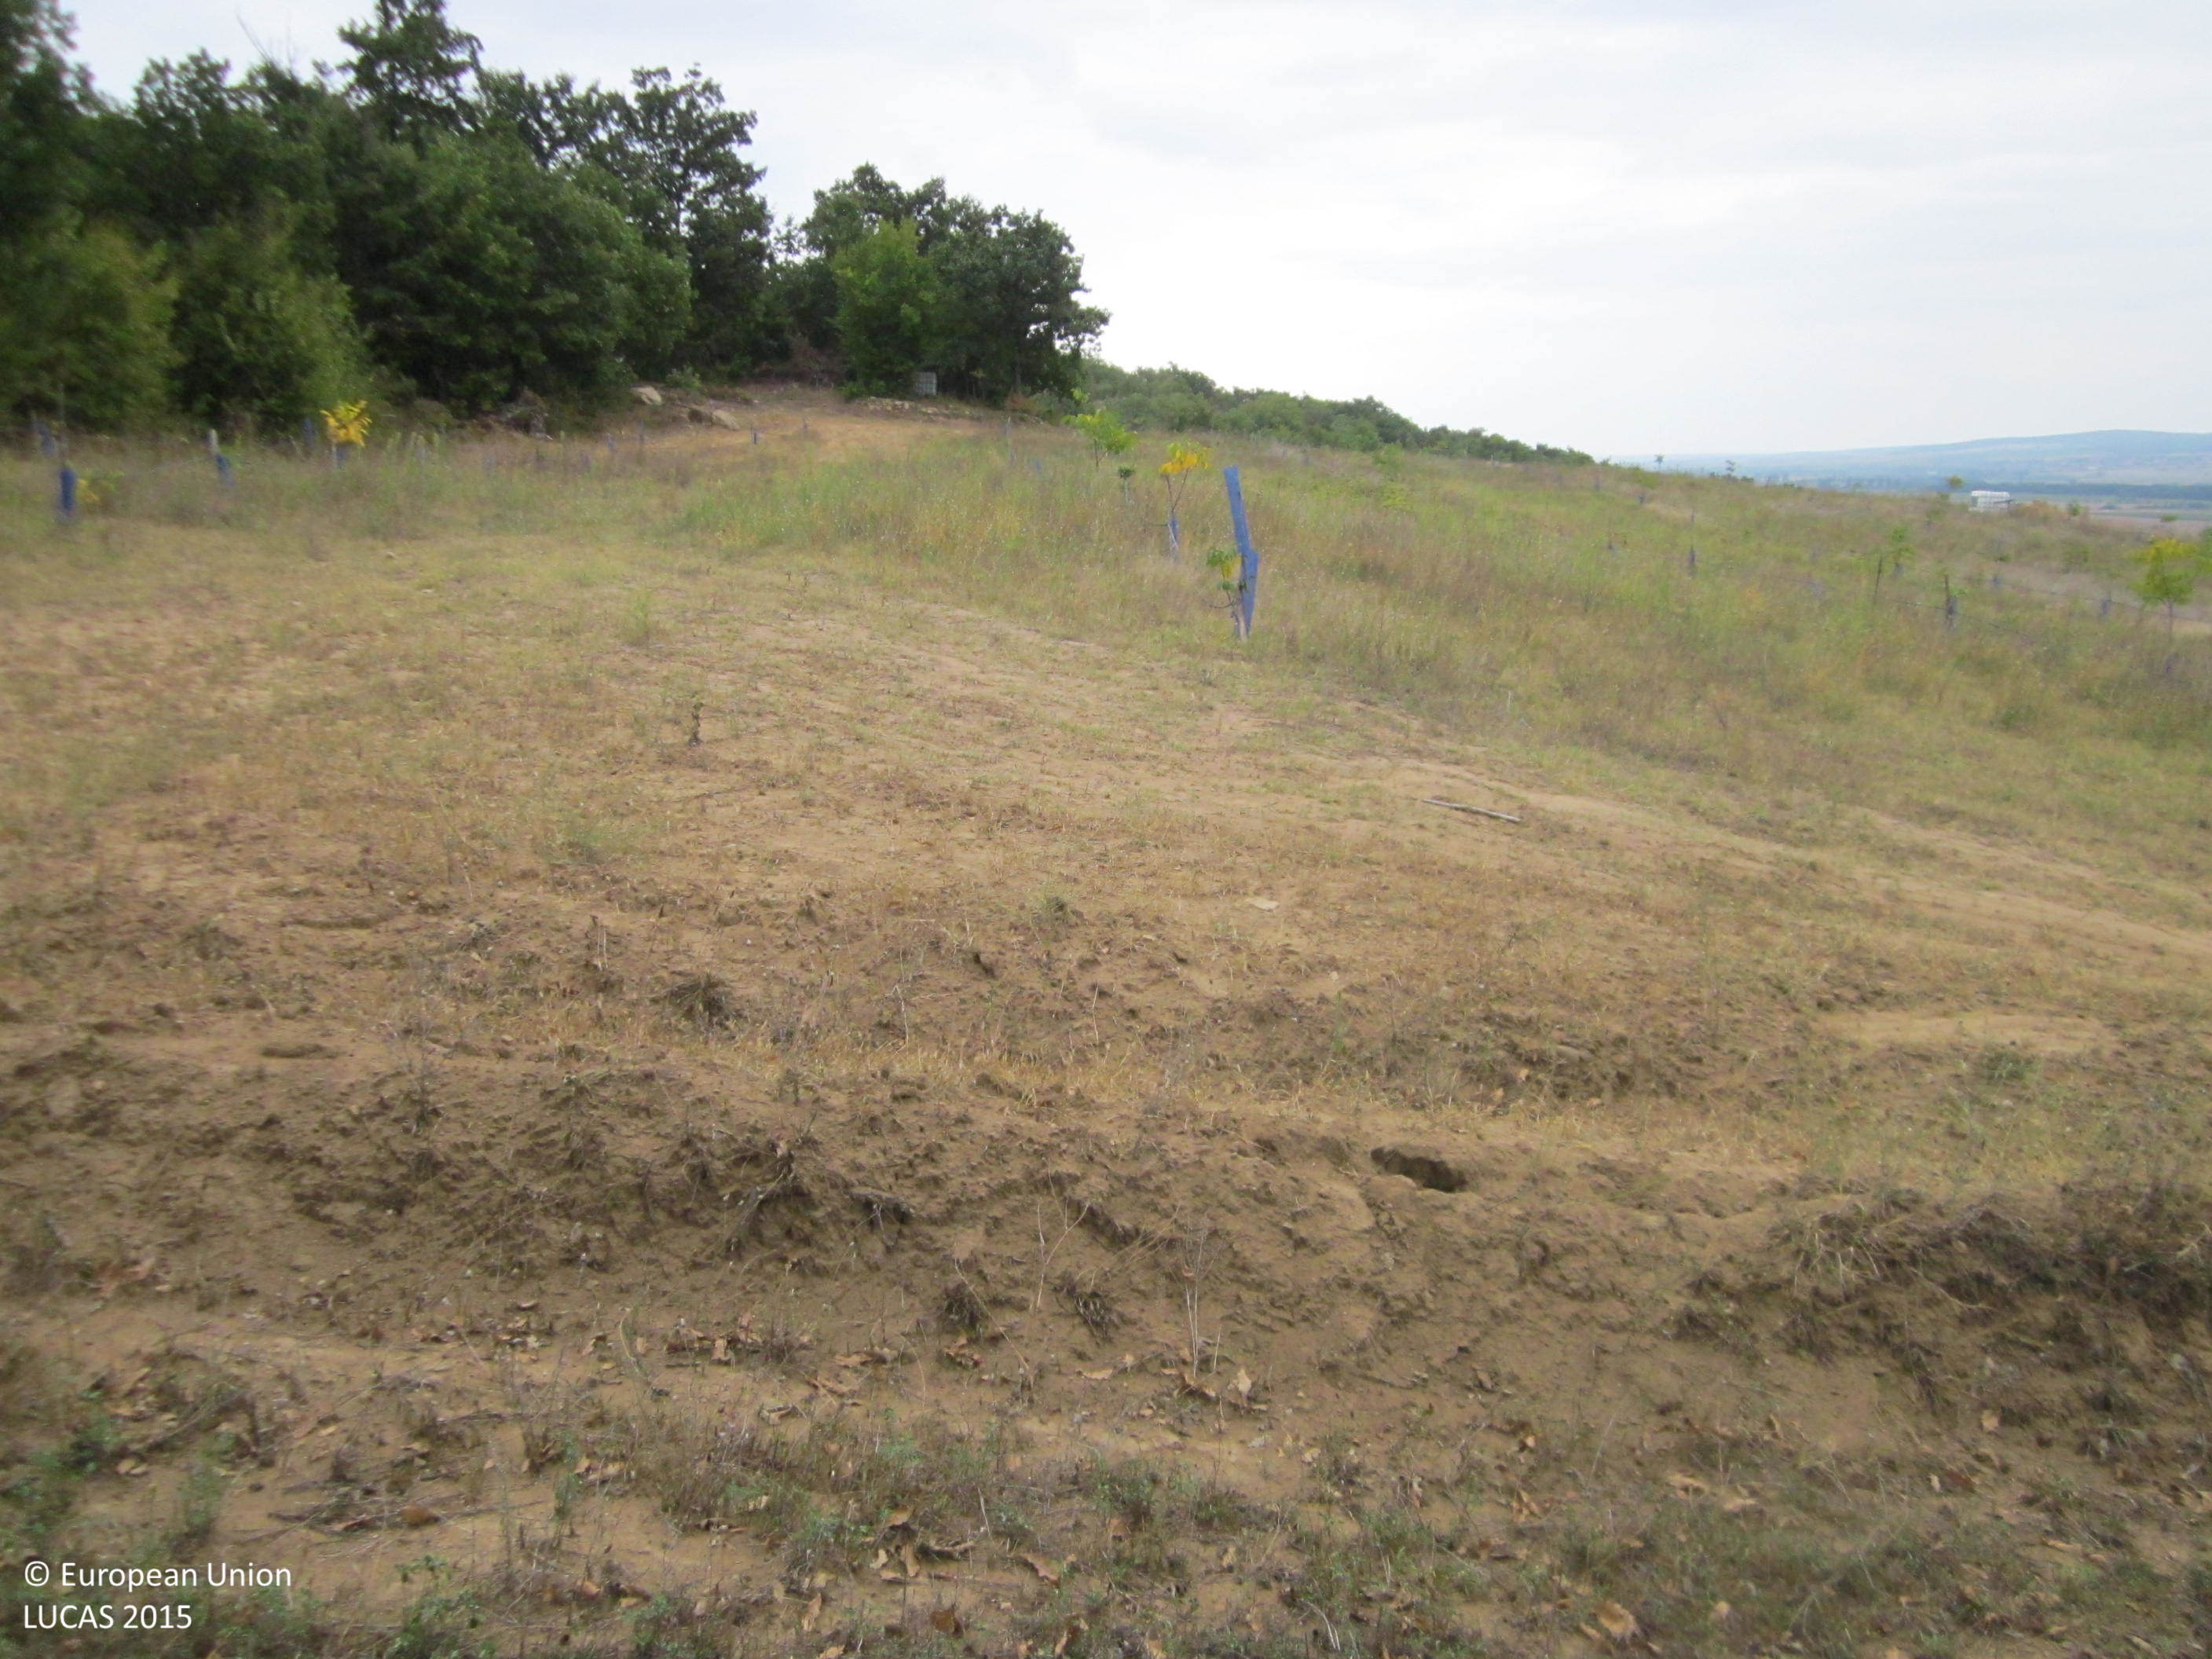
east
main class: Cropland
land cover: Nuts trees
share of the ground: 10 - 25 %
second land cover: Grassland without tree/shrub cover
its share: 25 - 50 %
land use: Agriculture (excluding fallow land and kitchen gardens)
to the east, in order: Nuts trees; Grassland without tree/shrub cover; Ditches and canals; Nuts trees; Broadleaved woodland; Nuts trees; Tracks; Broadleaved woodland
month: September
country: BG
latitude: 42.8114
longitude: 27.3995
